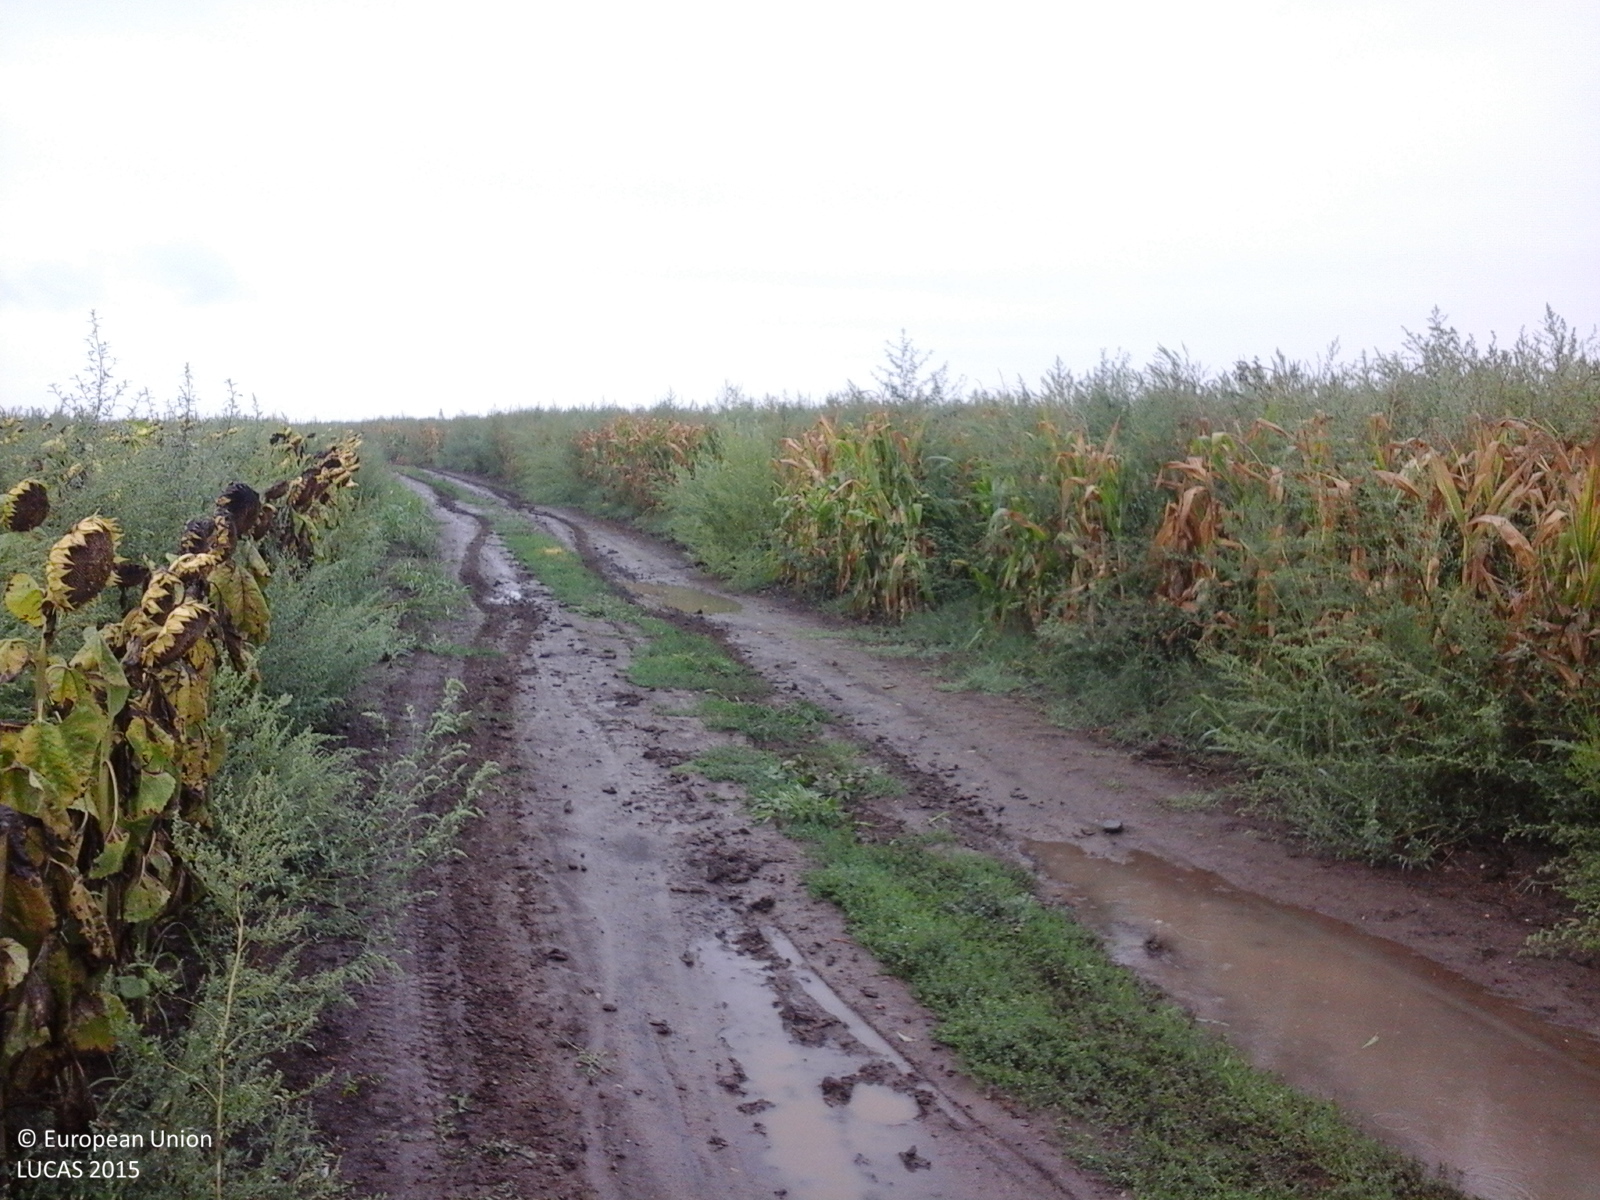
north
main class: Cropland
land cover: Sunflower
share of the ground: > 75 %
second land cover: Spontaneously vegetated surfaces
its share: 25 - 50 %
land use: Agriculture (excluding fallow land and kitchen gardens)
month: August
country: RO
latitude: 45.5864
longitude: 20.9598
